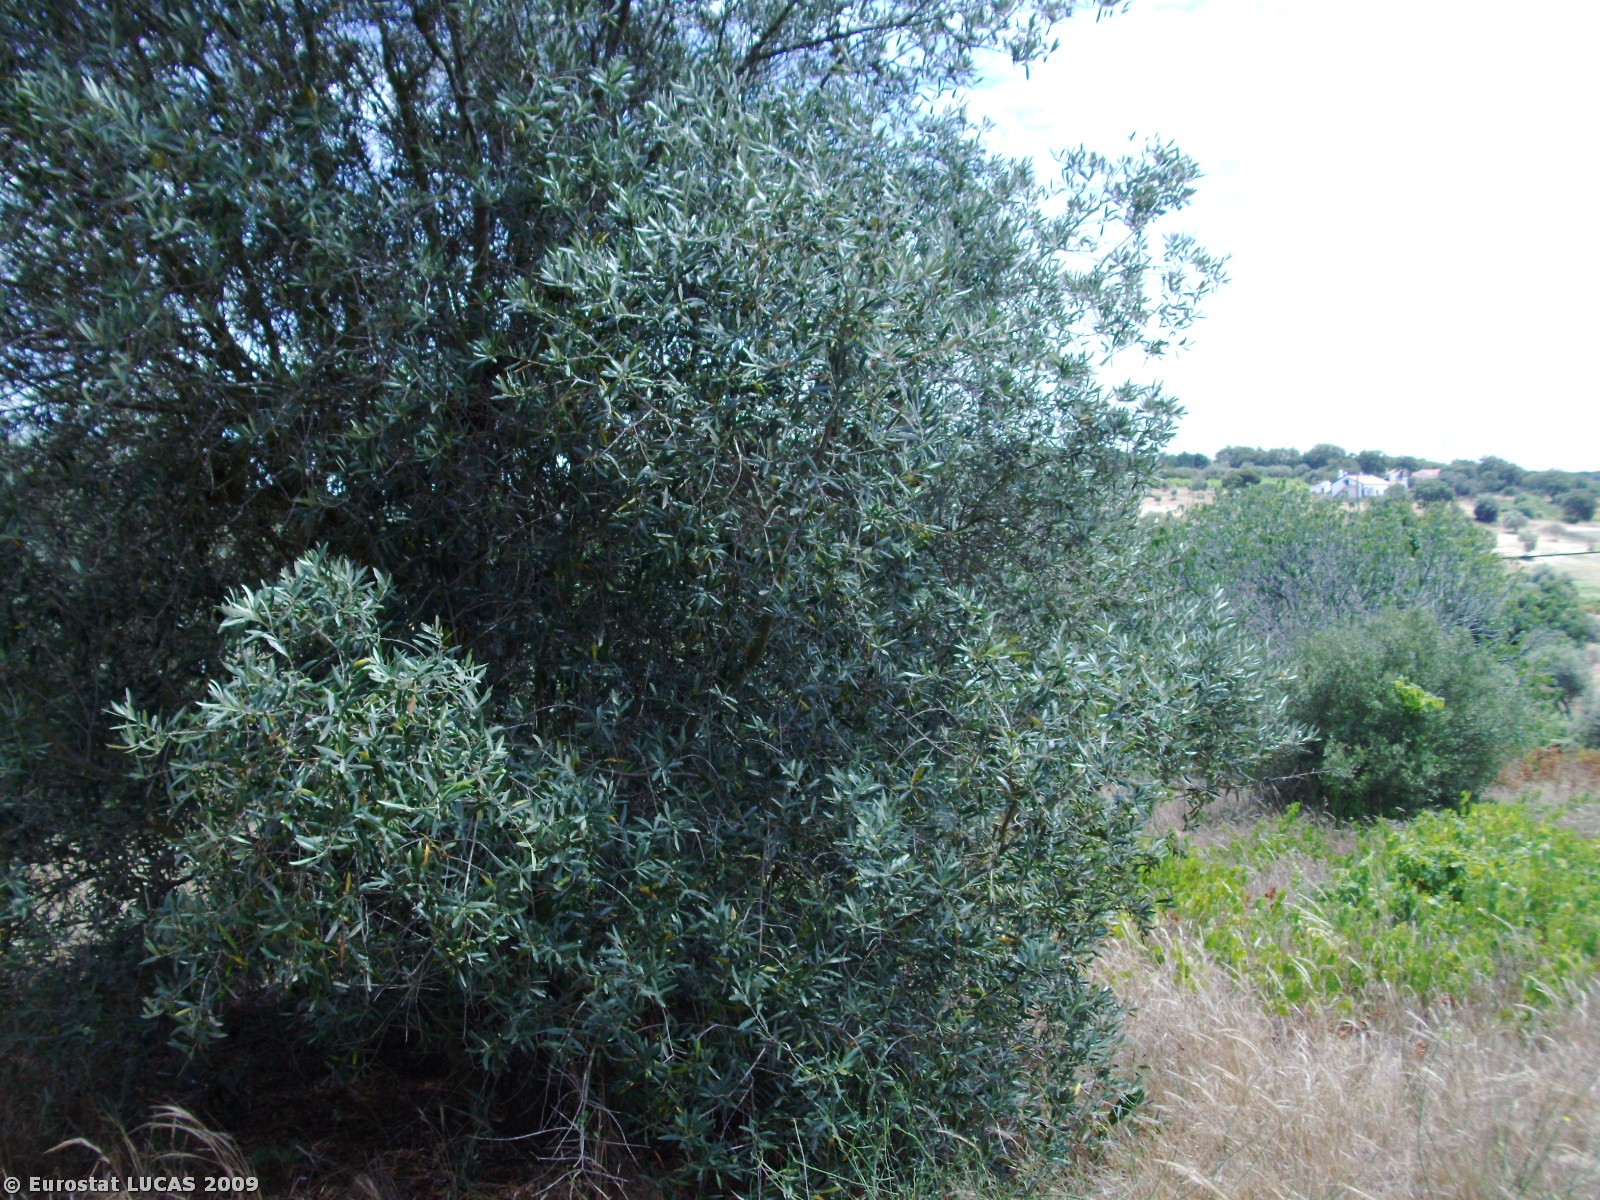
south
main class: Cropland
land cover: Olive groves
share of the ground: 10 - 25 %
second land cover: Spontaneously vegetated surfaces
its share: 50 - 75 %
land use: Agriculture (excluding fallow land and kitchen gardens)
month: June
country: PT
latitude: 38.1484
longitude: -8.7320
